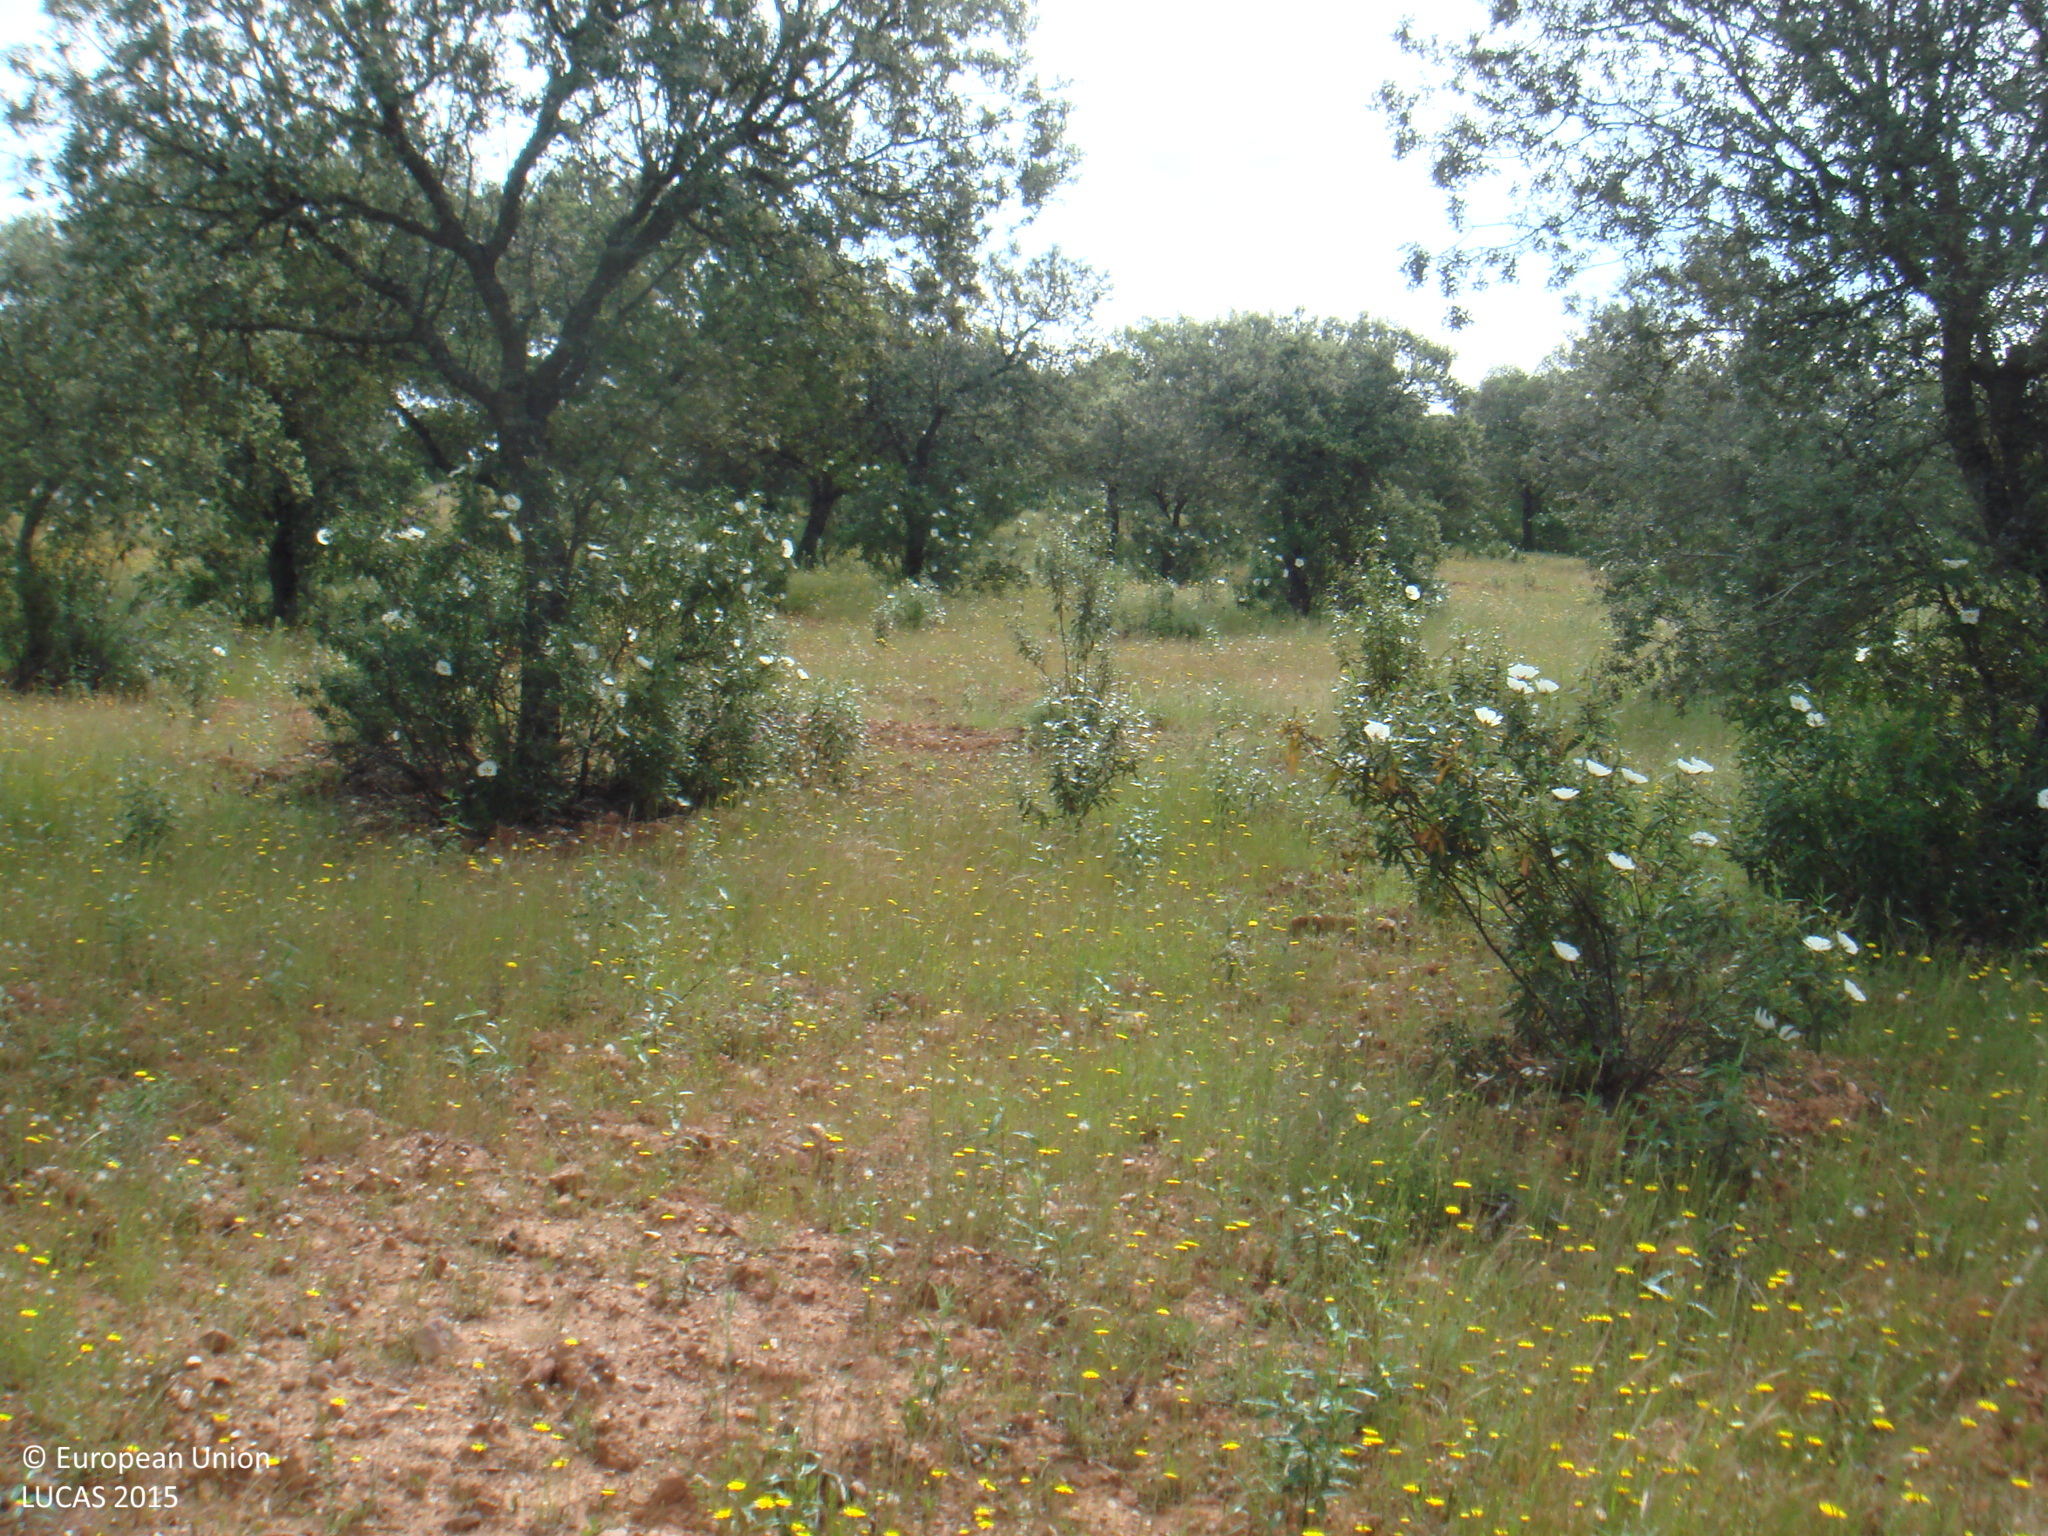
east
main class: Woodland
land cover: Broadleaved woodland
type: broadleaved evergreen forest
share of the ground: 25 - 50 %
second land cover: Shrubland without tree cover
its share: 25 - 50 %
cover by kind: herbaceous plants 50 %, shrubs 30 %, broadleaved forest trees 20 %
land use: Forestry
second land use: Agriculture (excluding fallow land and kitchen gardens)
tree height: > 5 m
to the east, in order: Broadleaved woodland; Shrubland without tree cover; Fences; Broadleaved woodland; Shrubland with sparse tree cover; Single bushes/trees; Olive groves
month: May
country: ES
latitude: 38.3526
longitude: -5.1204
